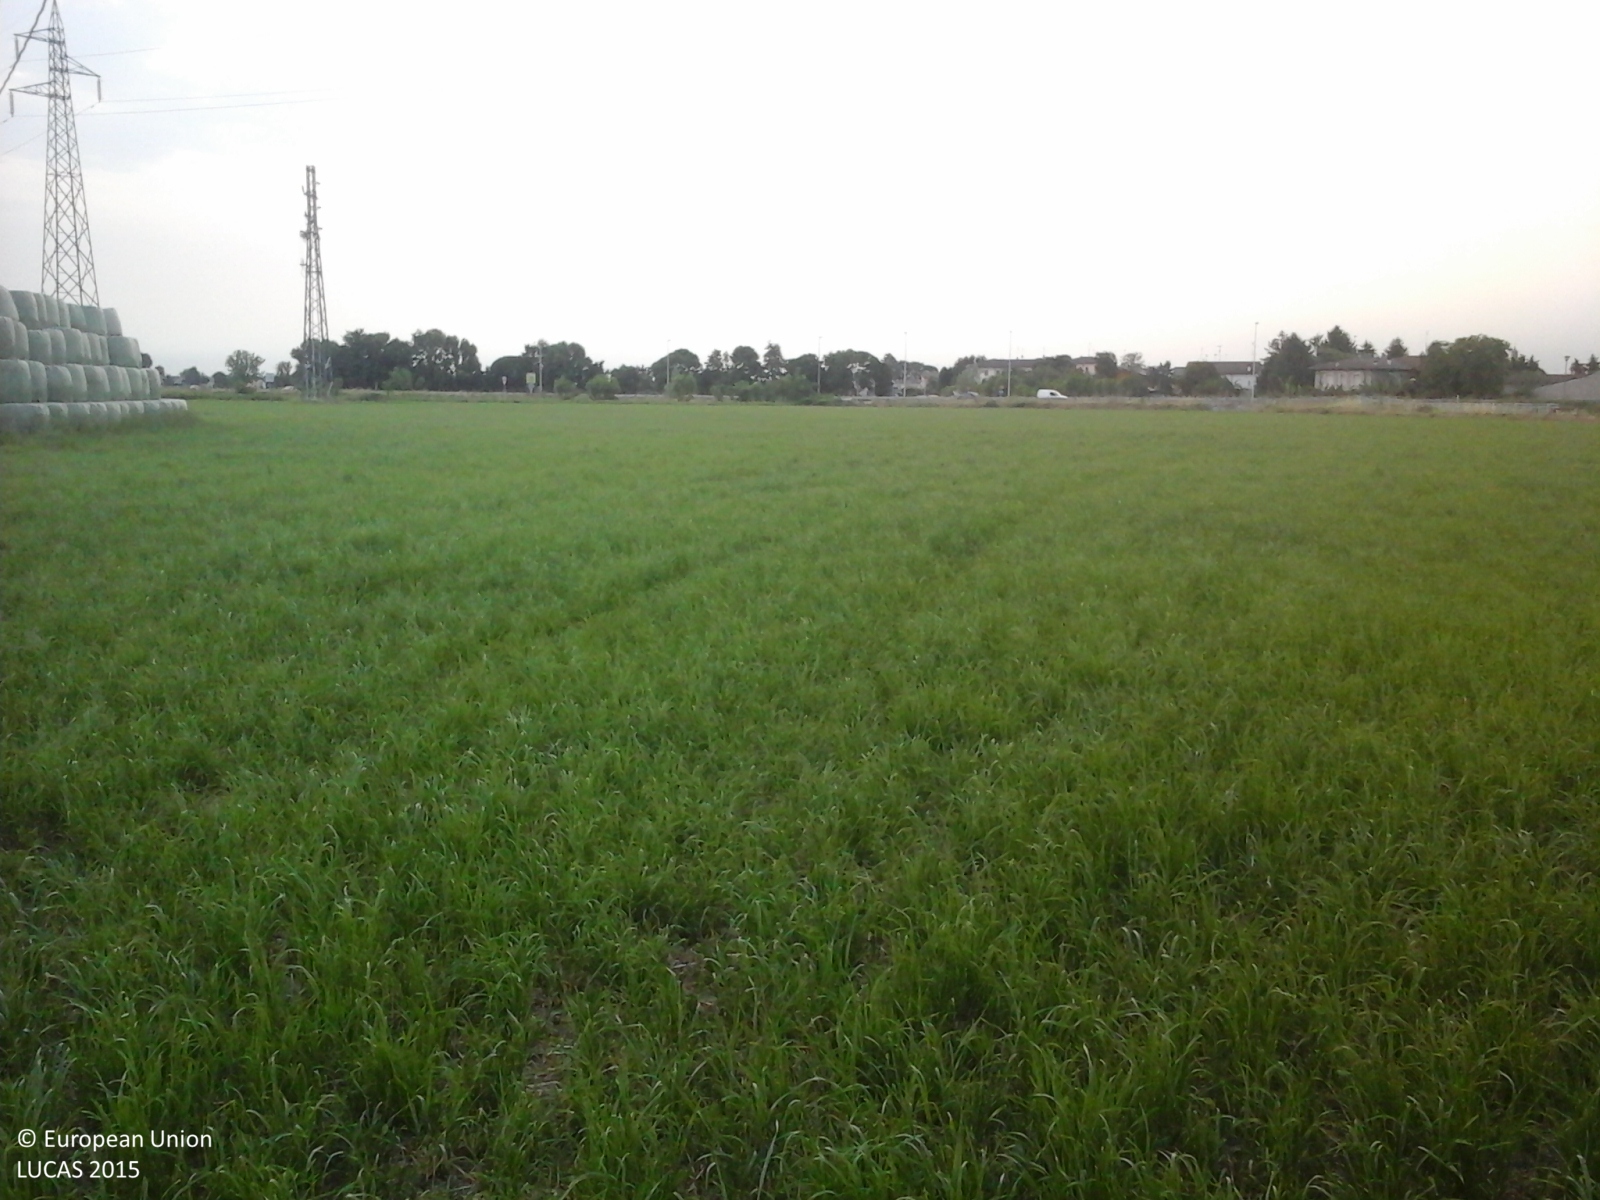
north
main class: Grassland
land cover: Grassland without tree/shrub cover
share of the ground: > 75 %
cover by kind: herbaceous plants 100 %
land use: Agriculture (excluding fallow land and kitchen gardens)
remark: Harvested field
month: May
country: IT
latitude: 45.2133
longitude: 10.7499
